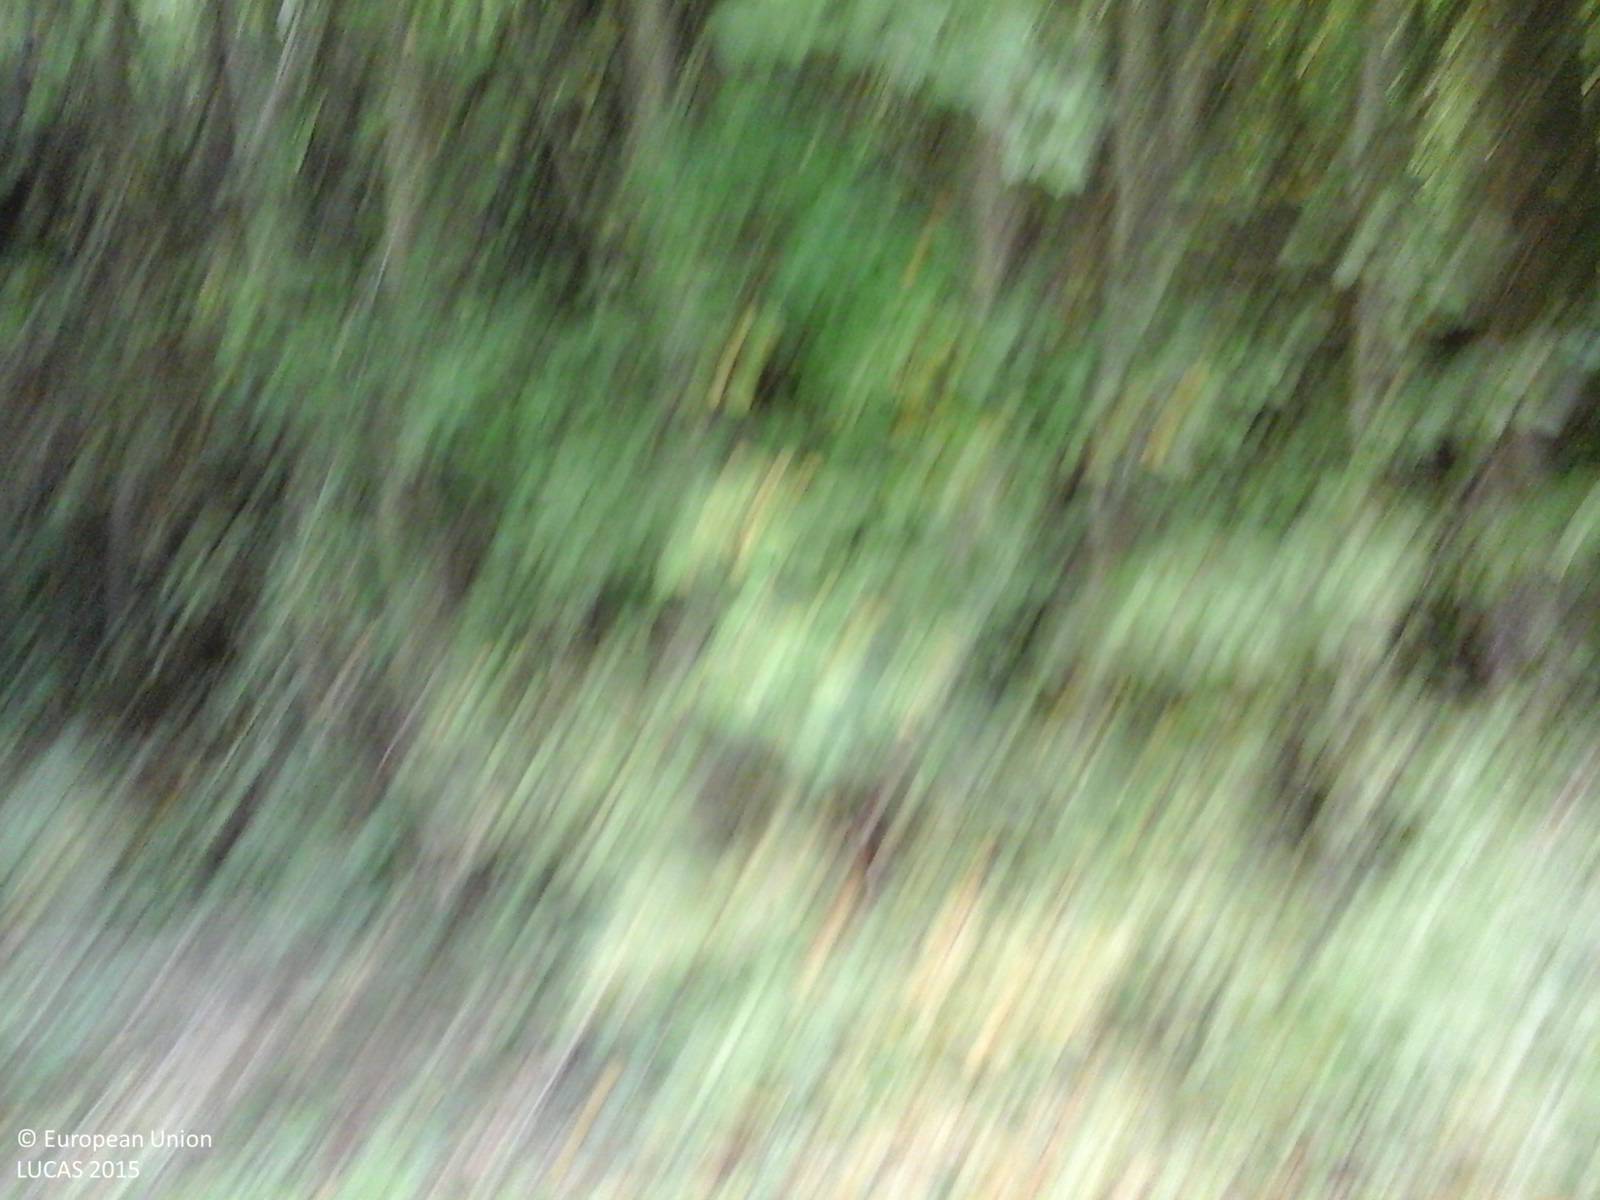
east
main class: Grassland
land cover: Grassland without tree/shrub cover
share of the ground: > 75 %
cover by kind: herbaceous plants 100 %
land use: Agriculture (excluding fallow land and kitchen gardens)
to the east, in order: Grassland without tree/shrub cover; Fences; Tracks; Broadleaved woodland; Grassland without tree/shrub cover; Broadleaved woodland
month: October
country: IT
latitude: 42.6021
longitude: 13.2443
